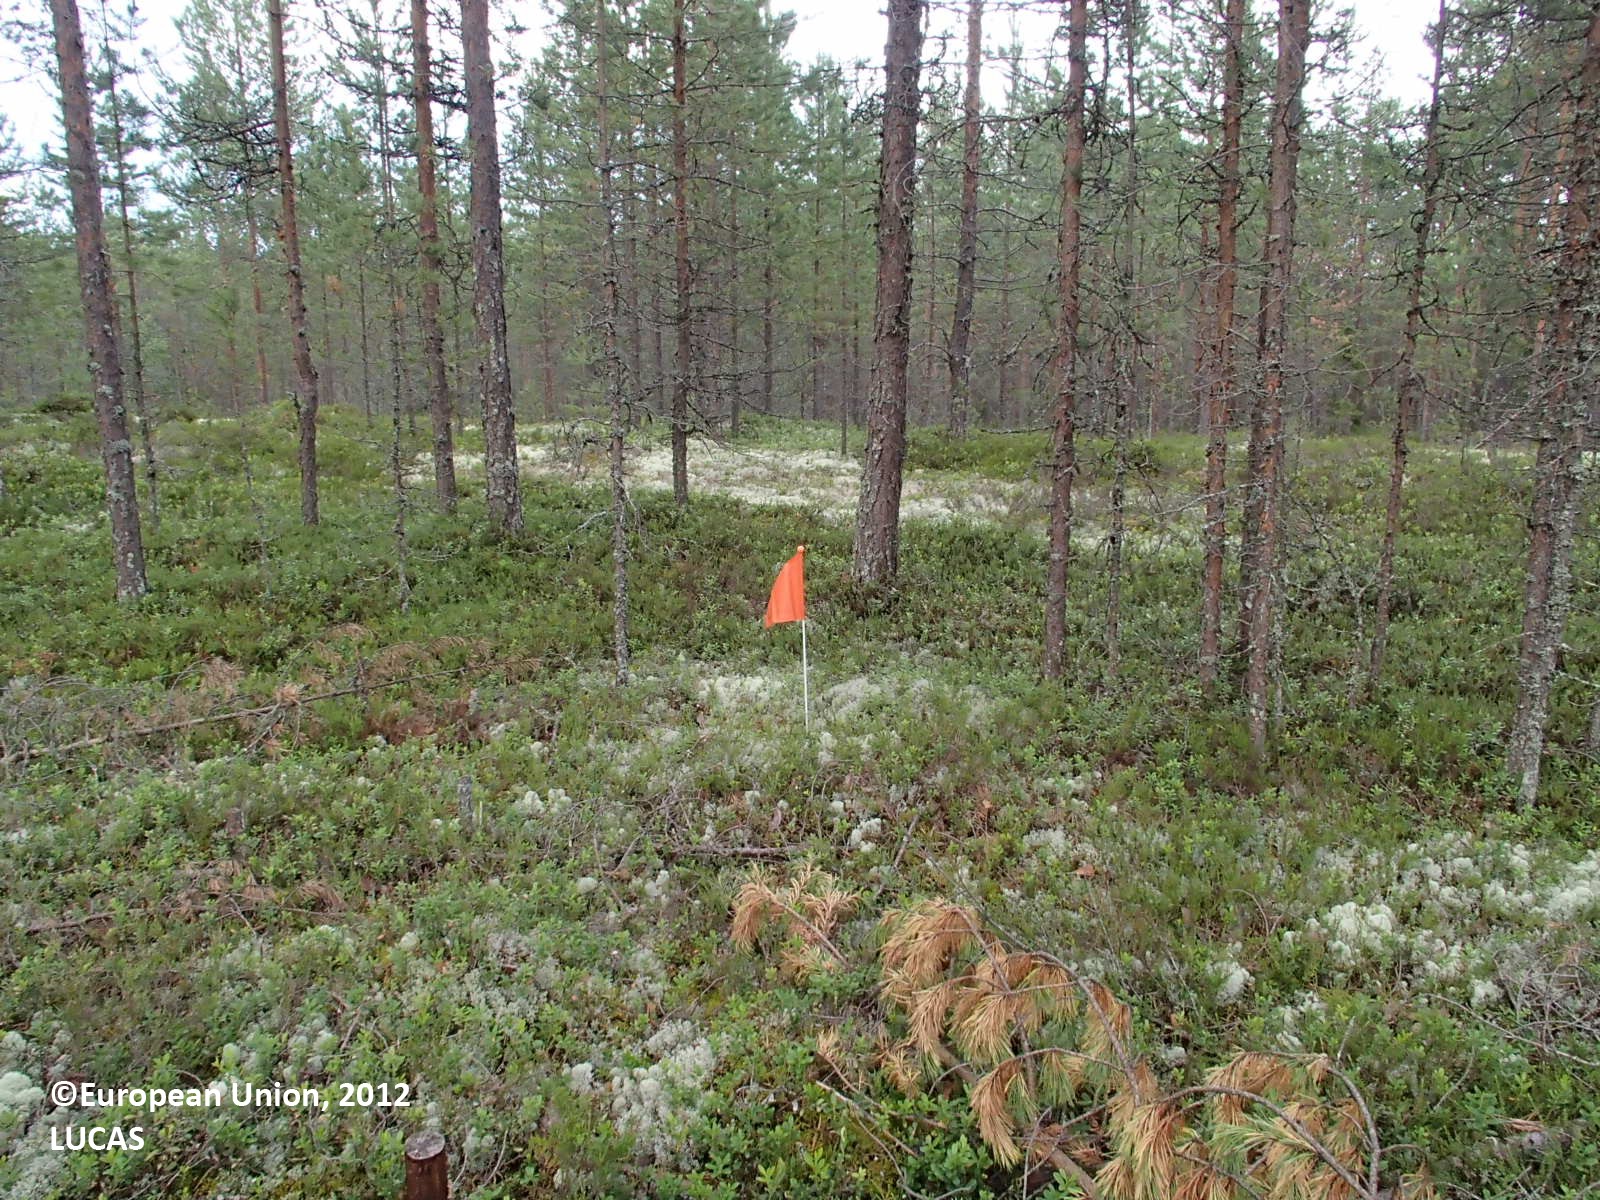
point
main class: Woodland
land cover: Pine dominated coniferous woodland
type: boreal forest
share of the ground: 50 - 75 %
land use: Forestry
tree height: > 5 m
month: July
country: FI
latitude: 64.3241
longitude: 26.3086
